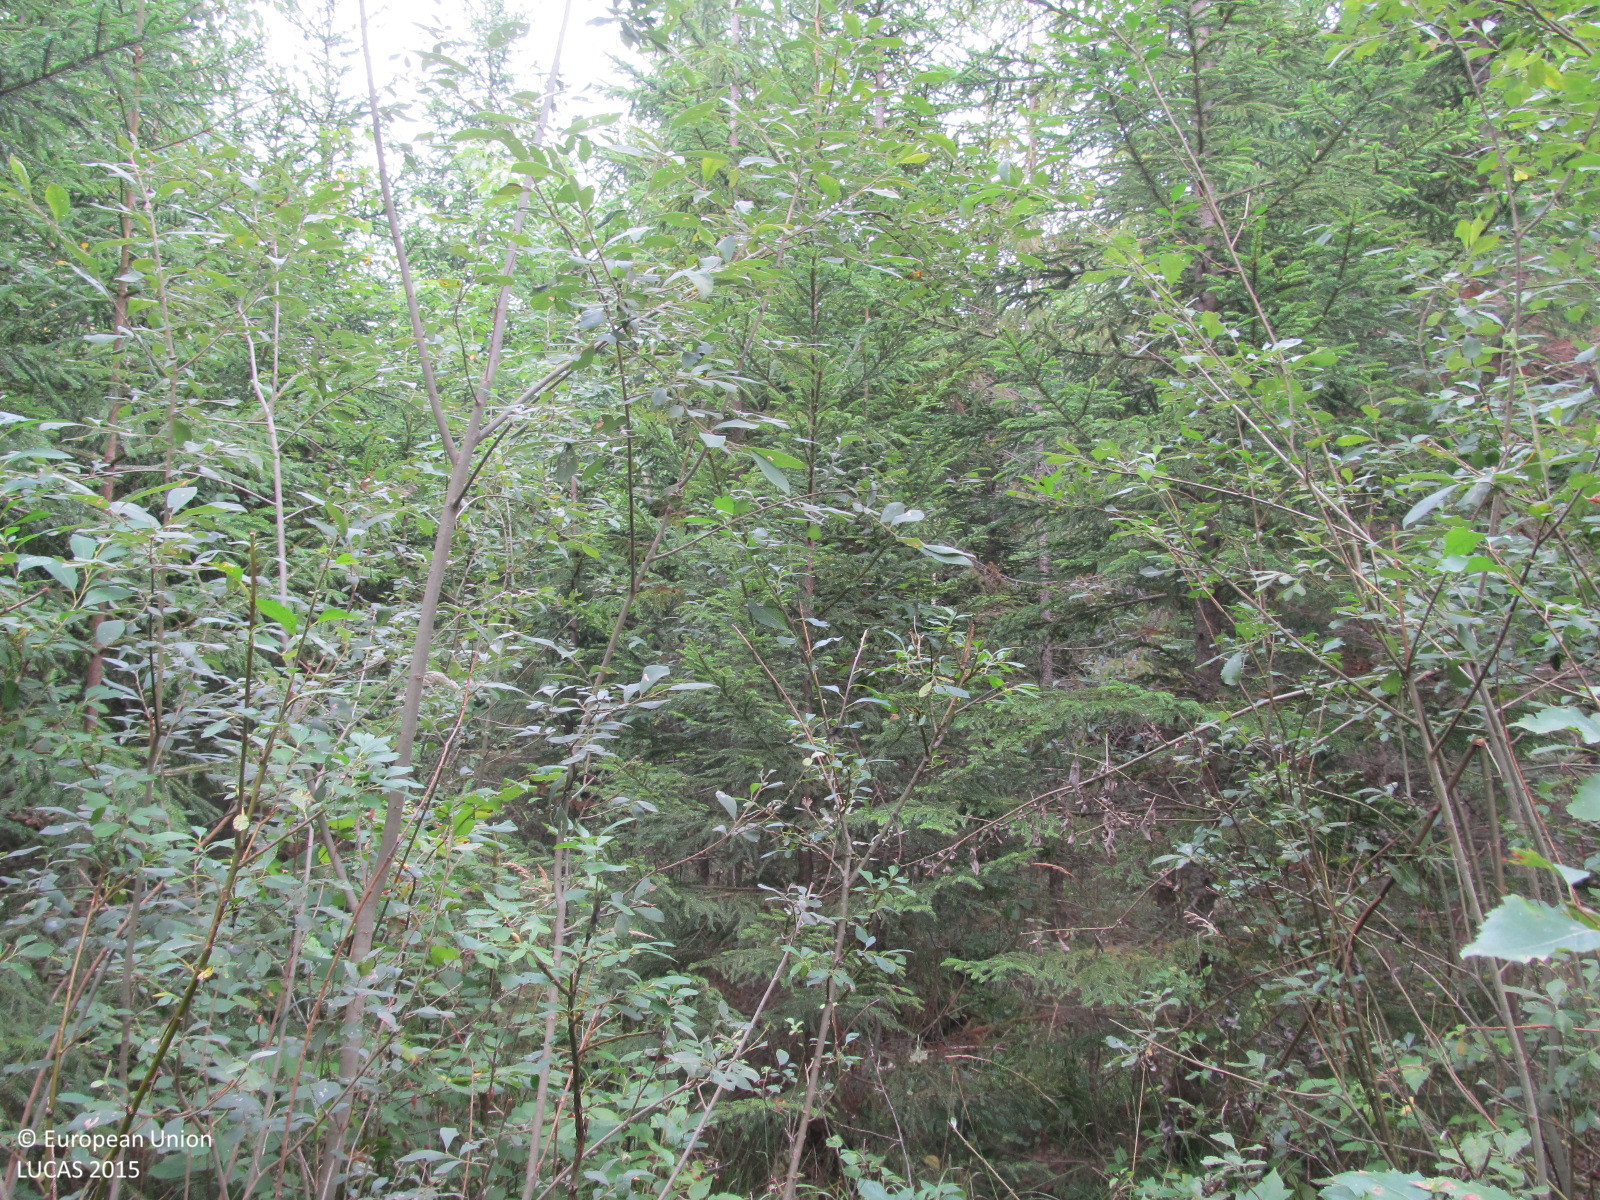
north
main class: Woodland
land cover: Spruce dominated mixed woodland
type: hemiboreal forest and nemoral coniferous forest and mixed broadleaved-coniferous forest
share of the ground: > 75 %
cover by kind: coniferous forest trees 50 %, broadleaved forest trees 30 %, shrubs 10 %, herbaceous plants 5 %, lichens and mosses 5 %
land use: Forestry
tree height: > 5 m
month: September
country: LT
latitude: 56.2862
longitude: 23.2040
